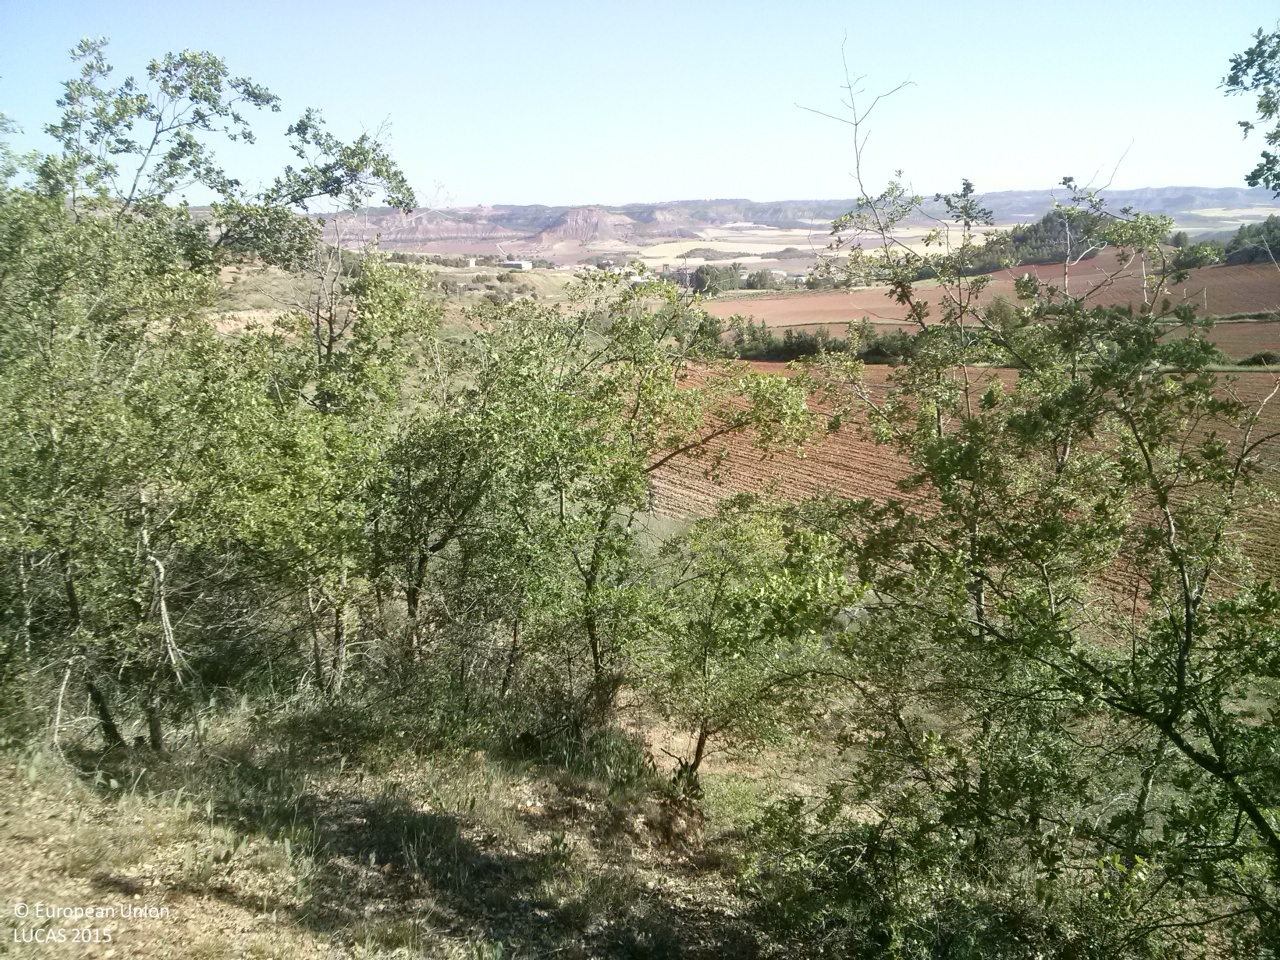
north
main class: Woodland
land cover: Broadleaved woodland
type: thermophilous deciduous forest
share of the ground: 25 - 50 %
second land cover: Grassland without tree/shrub cover
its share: 25 - 50 %
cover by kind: broadleaved forest trees 50 %, herbaceous plants 35 %, unconsolidated bare surface 10 %, shrubs 5 %
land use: Forestry
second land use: Agriculture (excluding fallow land and kitchen gardens)
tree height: < 5 m
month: May
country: ES
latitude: 40.1325
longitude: -2.5664
